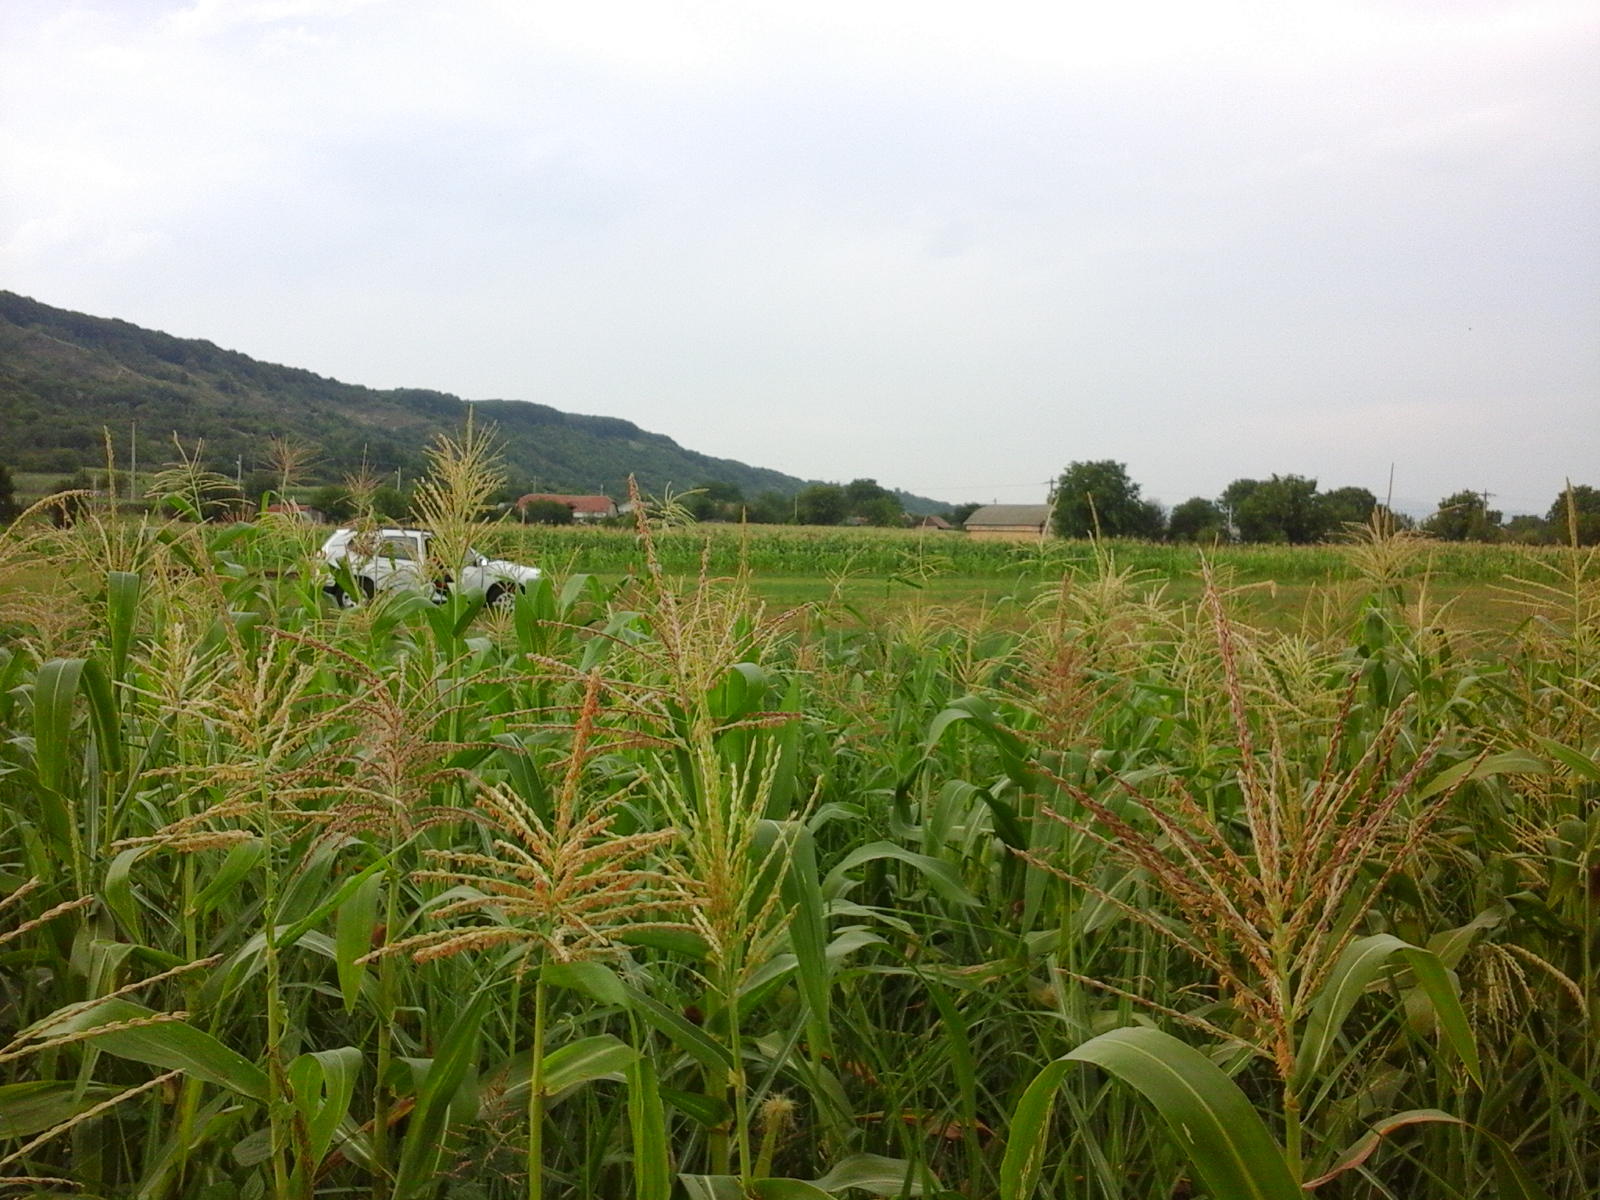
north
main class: Cropland
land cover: Maize
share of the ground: > 75 %
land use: Agriculture (excluding fallow land and kitchen gardens)
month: July
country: RO
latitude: 46.1966
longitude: 26.7378
